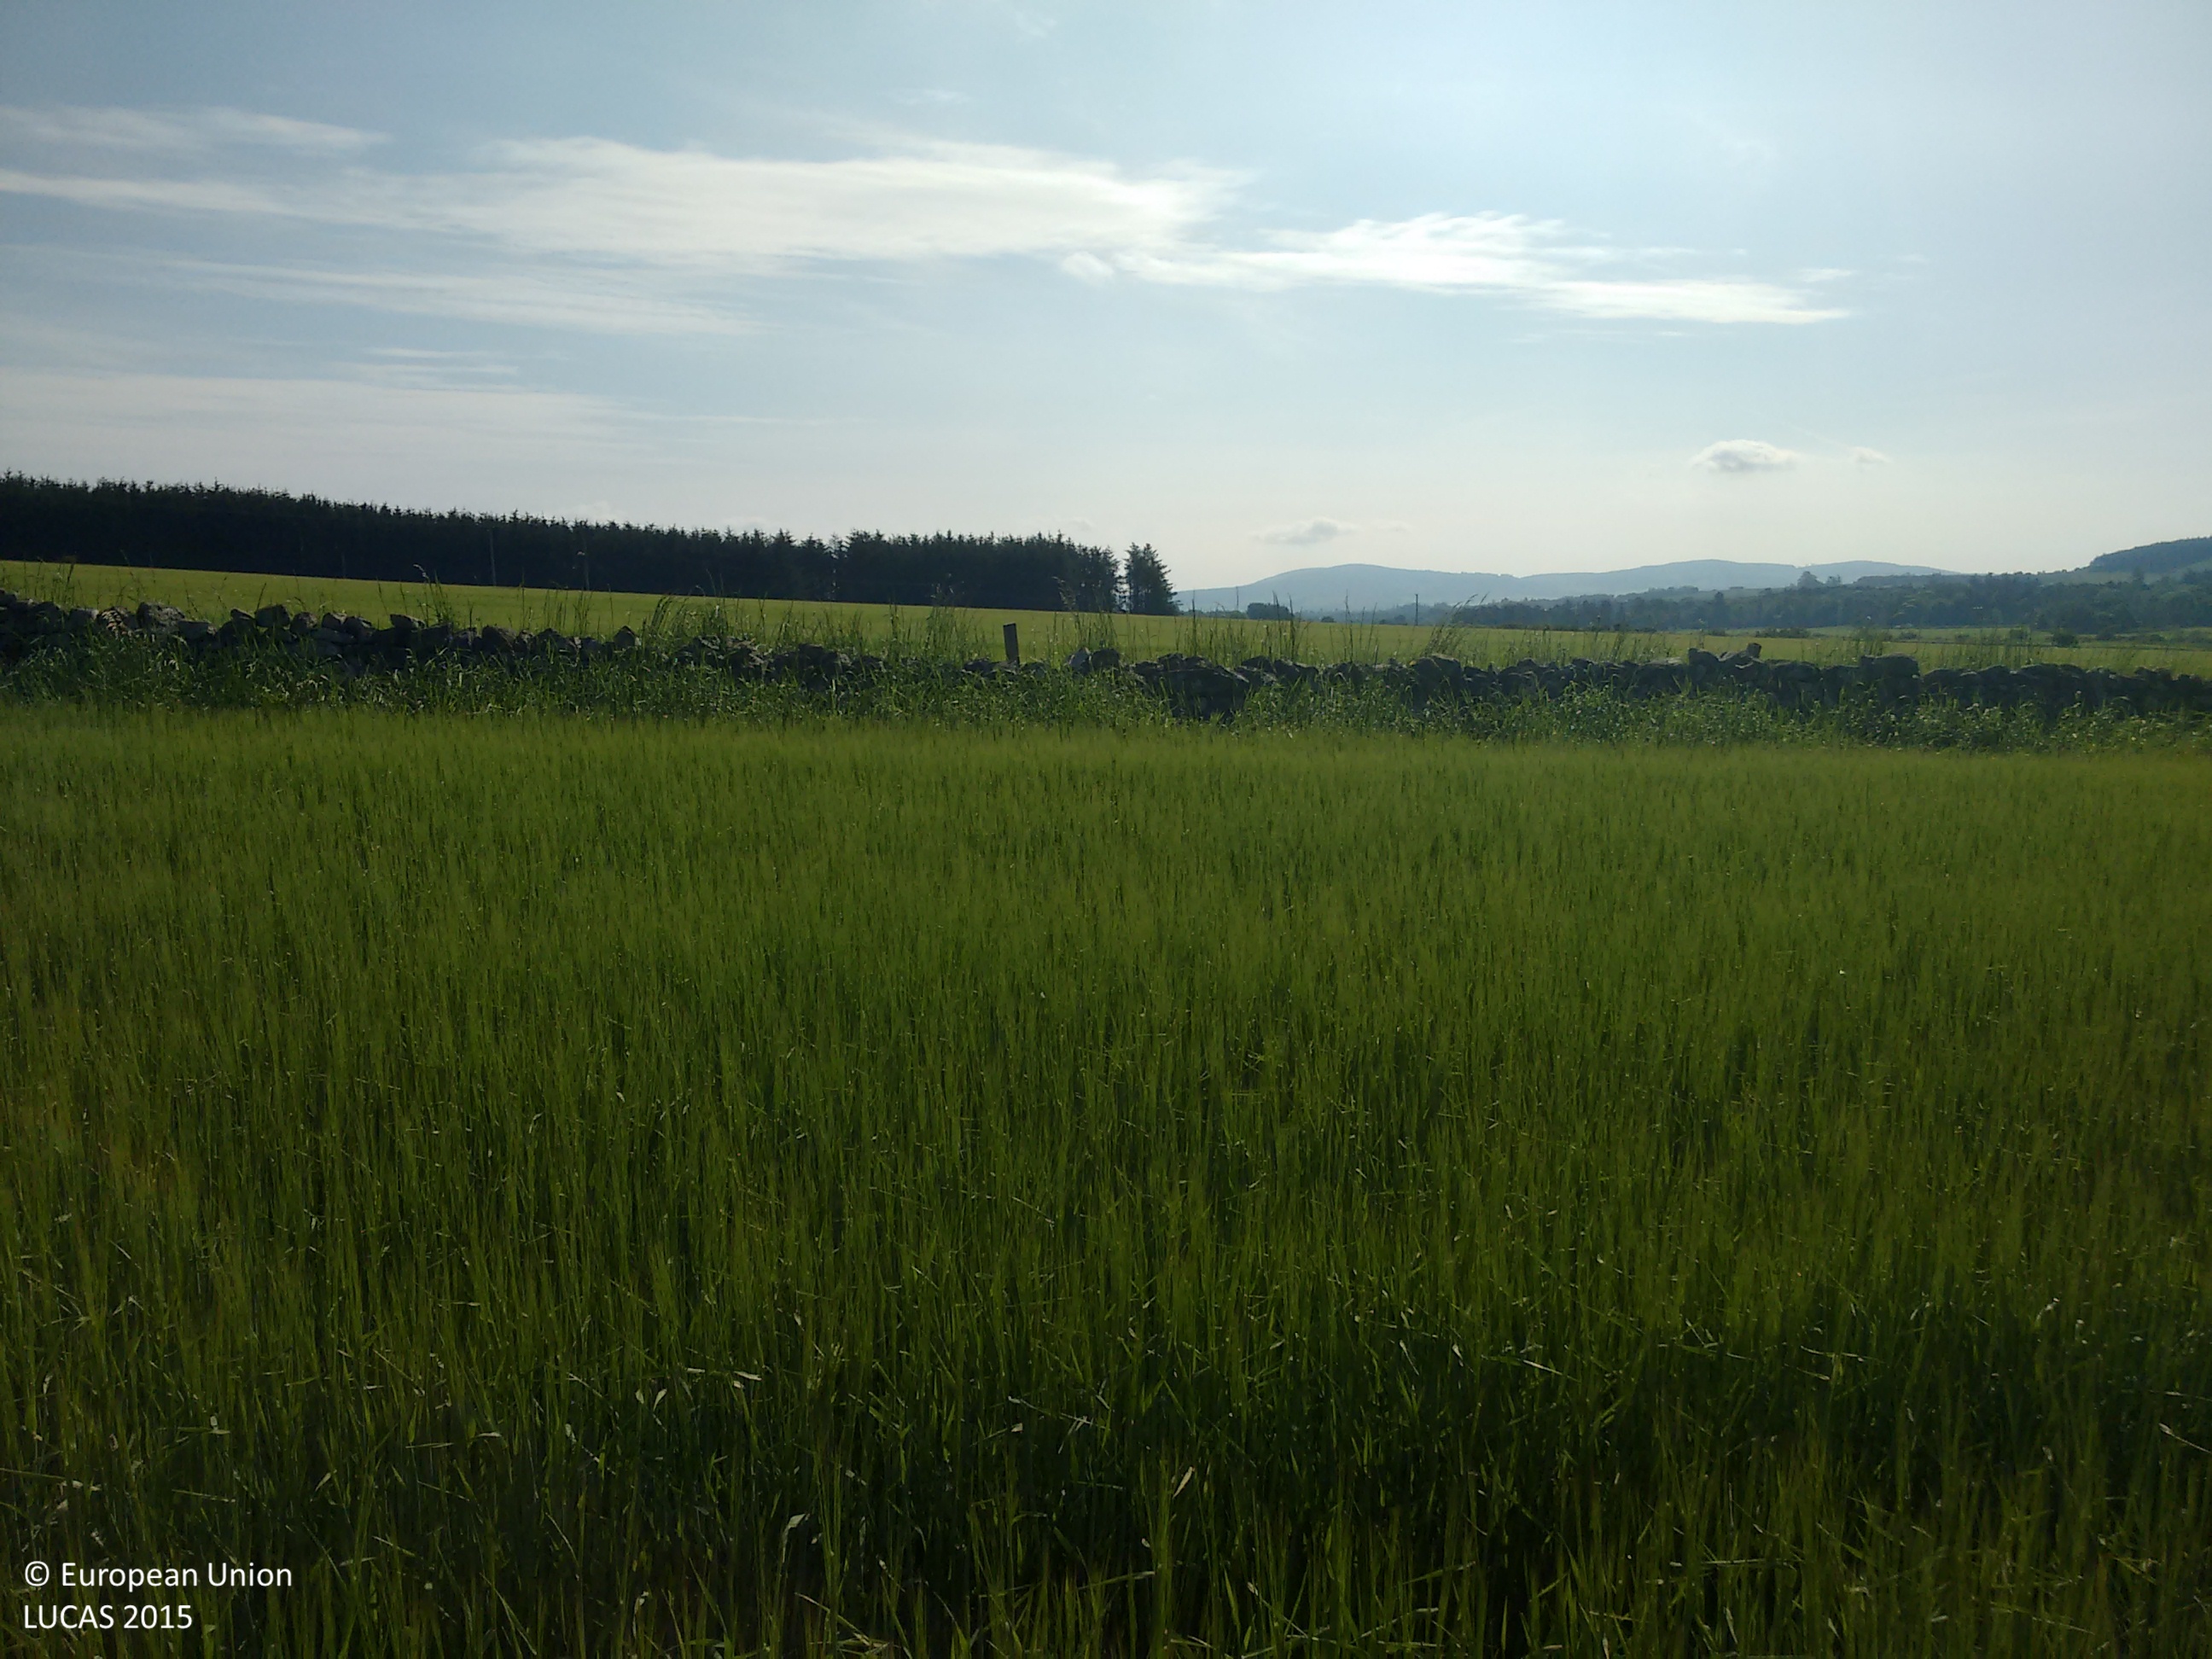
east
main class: Cropland
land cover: Barley
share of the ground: > 75 %
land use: Agriculture (excluding fallow land and kitchen gardens)
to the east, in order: Barley; Grass margins; Dry stone walls; Grass margins; Barley; Grass margins; Dry stone walls; Shruby margins; Grass margins; Ditches and canals; Paved roads, cycling and walking lanes; Grass margins; Dry stone walls; Fences; Grass margins; Barley
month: July
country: GB
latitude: 57.2424
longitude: -2.7681
